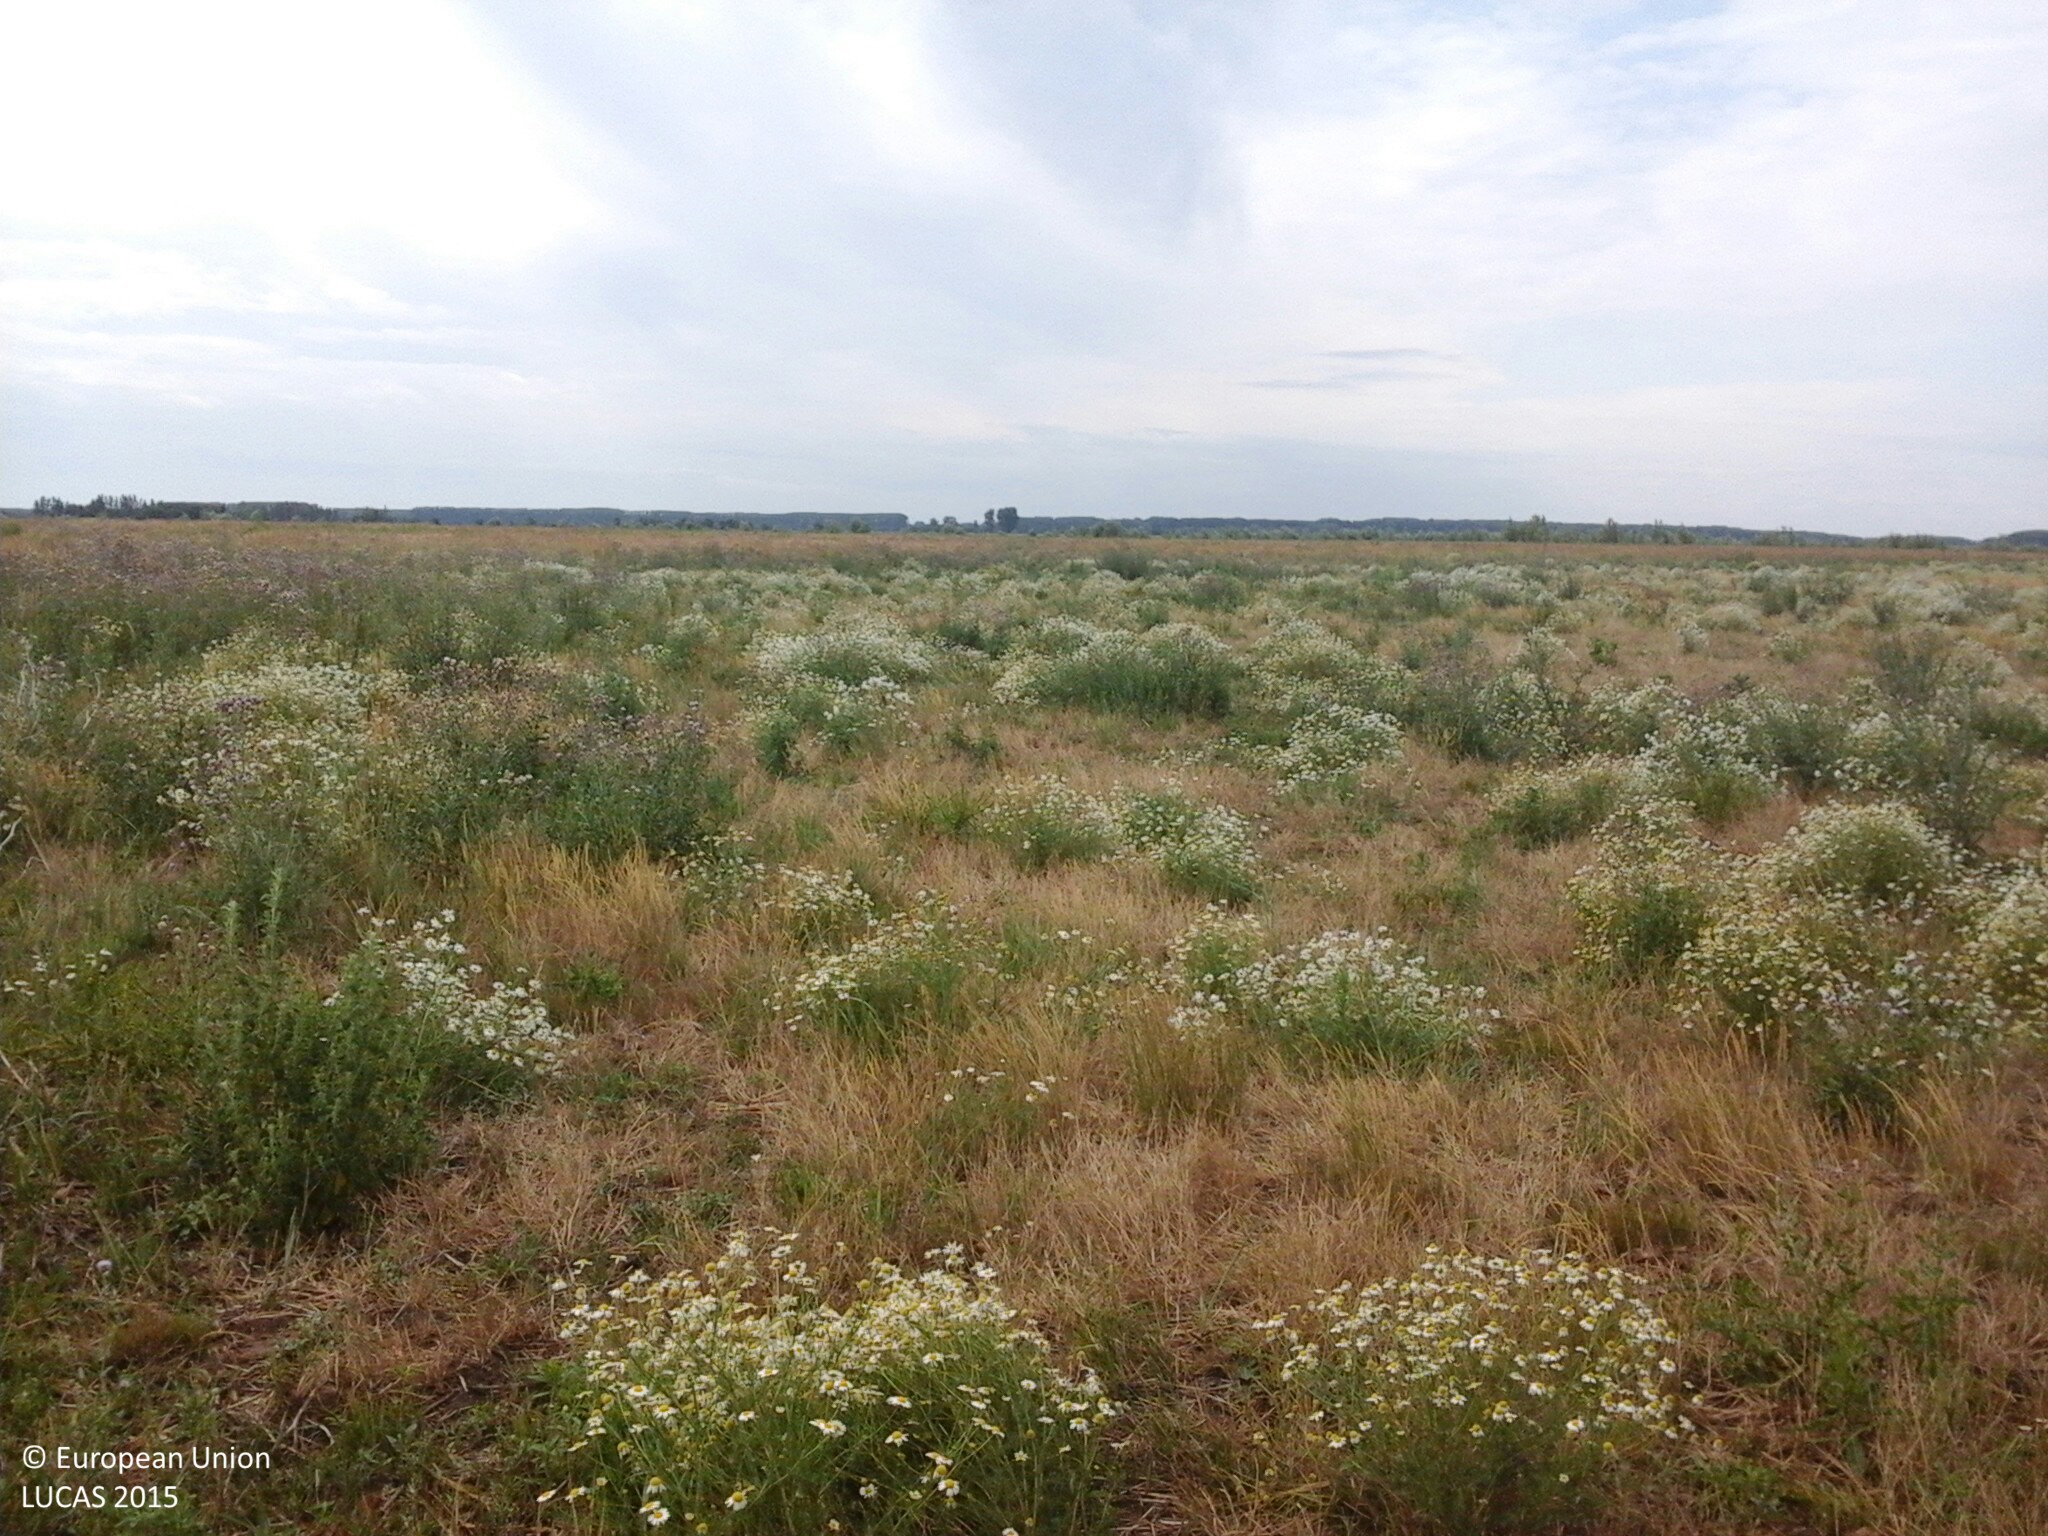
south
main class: Grassland
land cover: Spontaneously vegetated surfaces
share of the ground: > 75 %
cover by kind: herbaceous plants 100 %
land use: Semi-natural and natural areas not in use
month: July
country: HU
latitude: 48.2739
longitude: 21.8406
